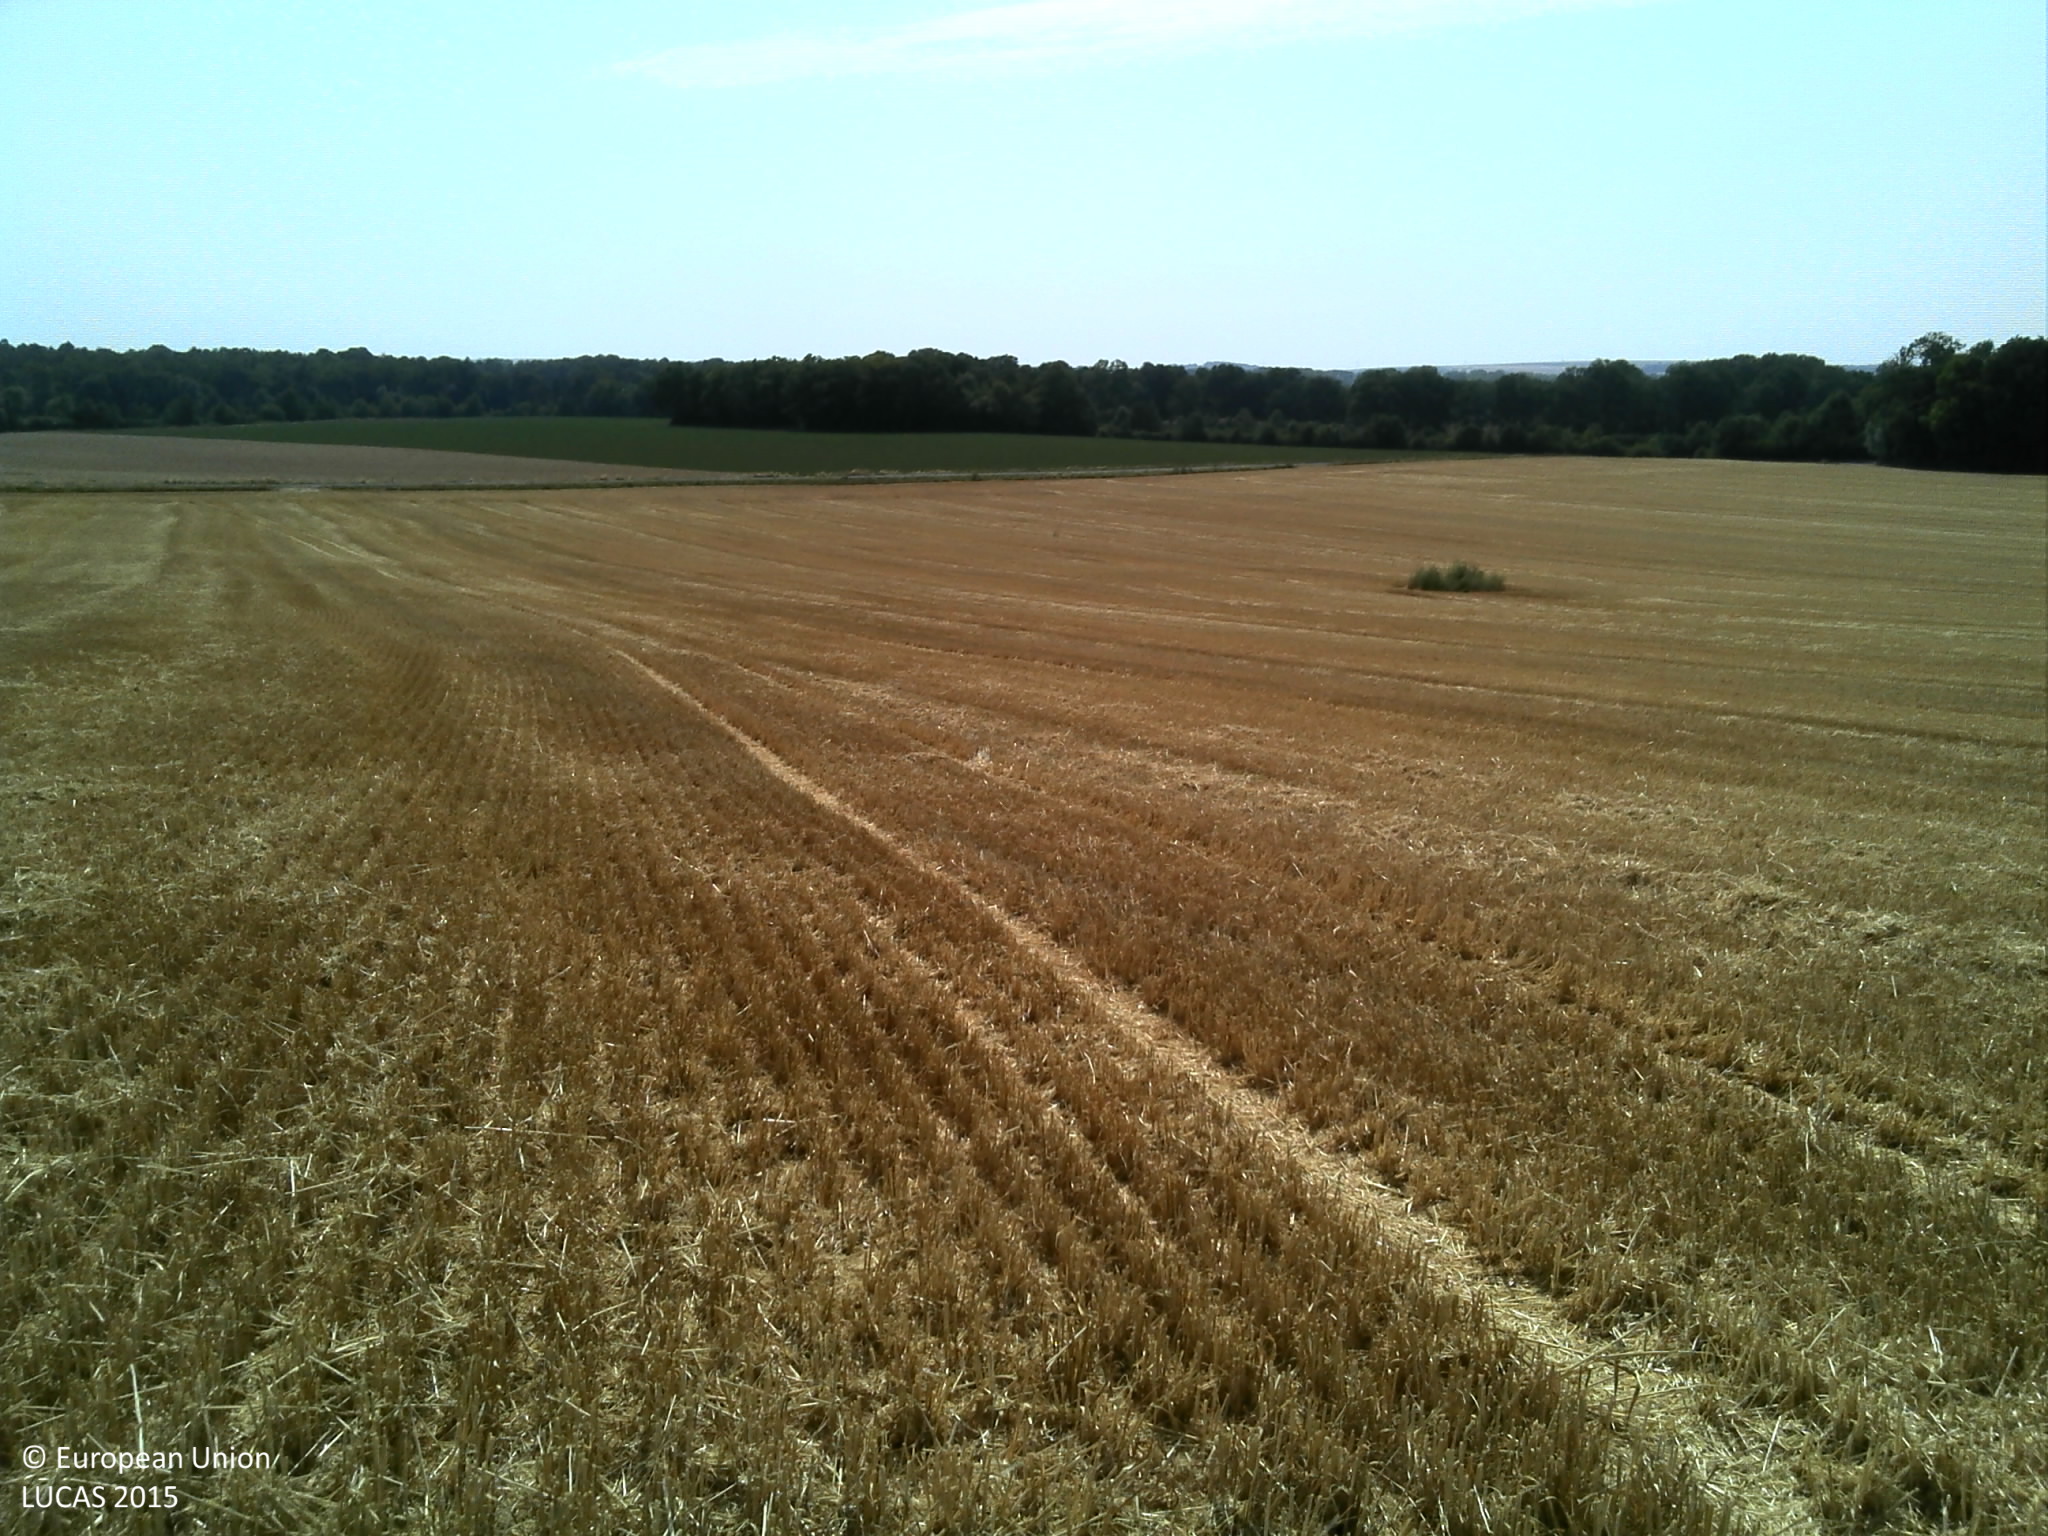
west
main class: Cropland
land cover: Common wheat
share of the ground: > 75 %
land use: Agriculture (excluding fallow land and kitchen gardens)
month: July
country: FR
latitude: 48.8775
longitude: 4.8298
